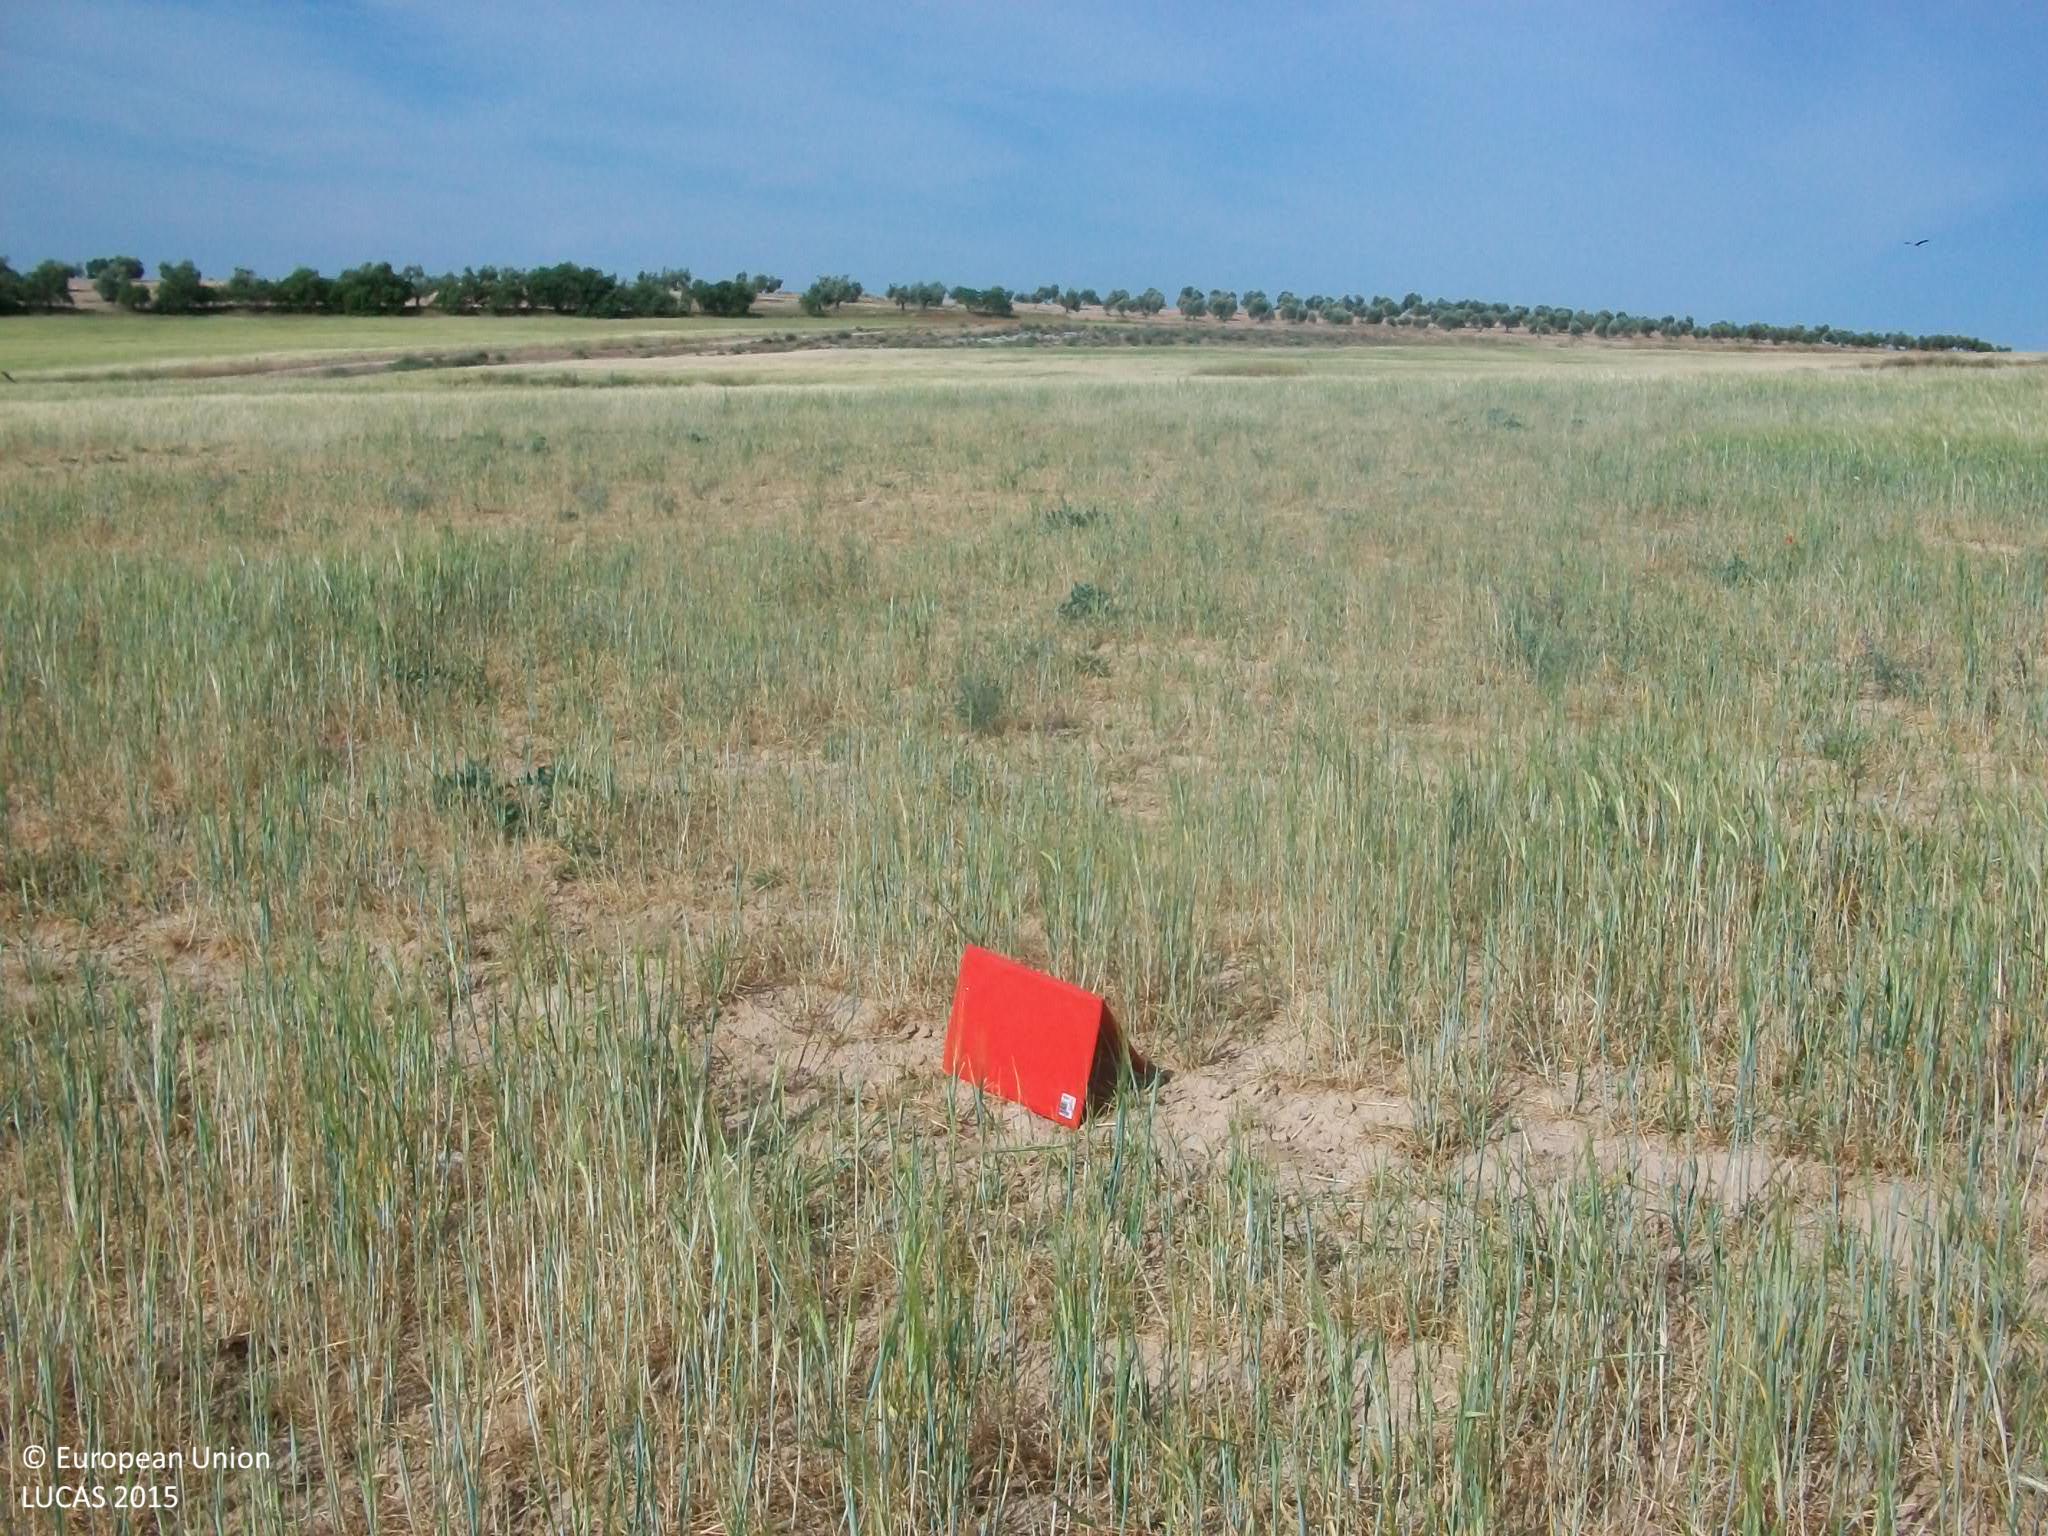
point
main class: Cropland
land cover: Barley
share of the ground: 50 - 75 %
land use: Agriculture (excluding fallow land and kitchen gardens)
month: May
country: ES
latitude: 40.0685
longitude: -3.7162
